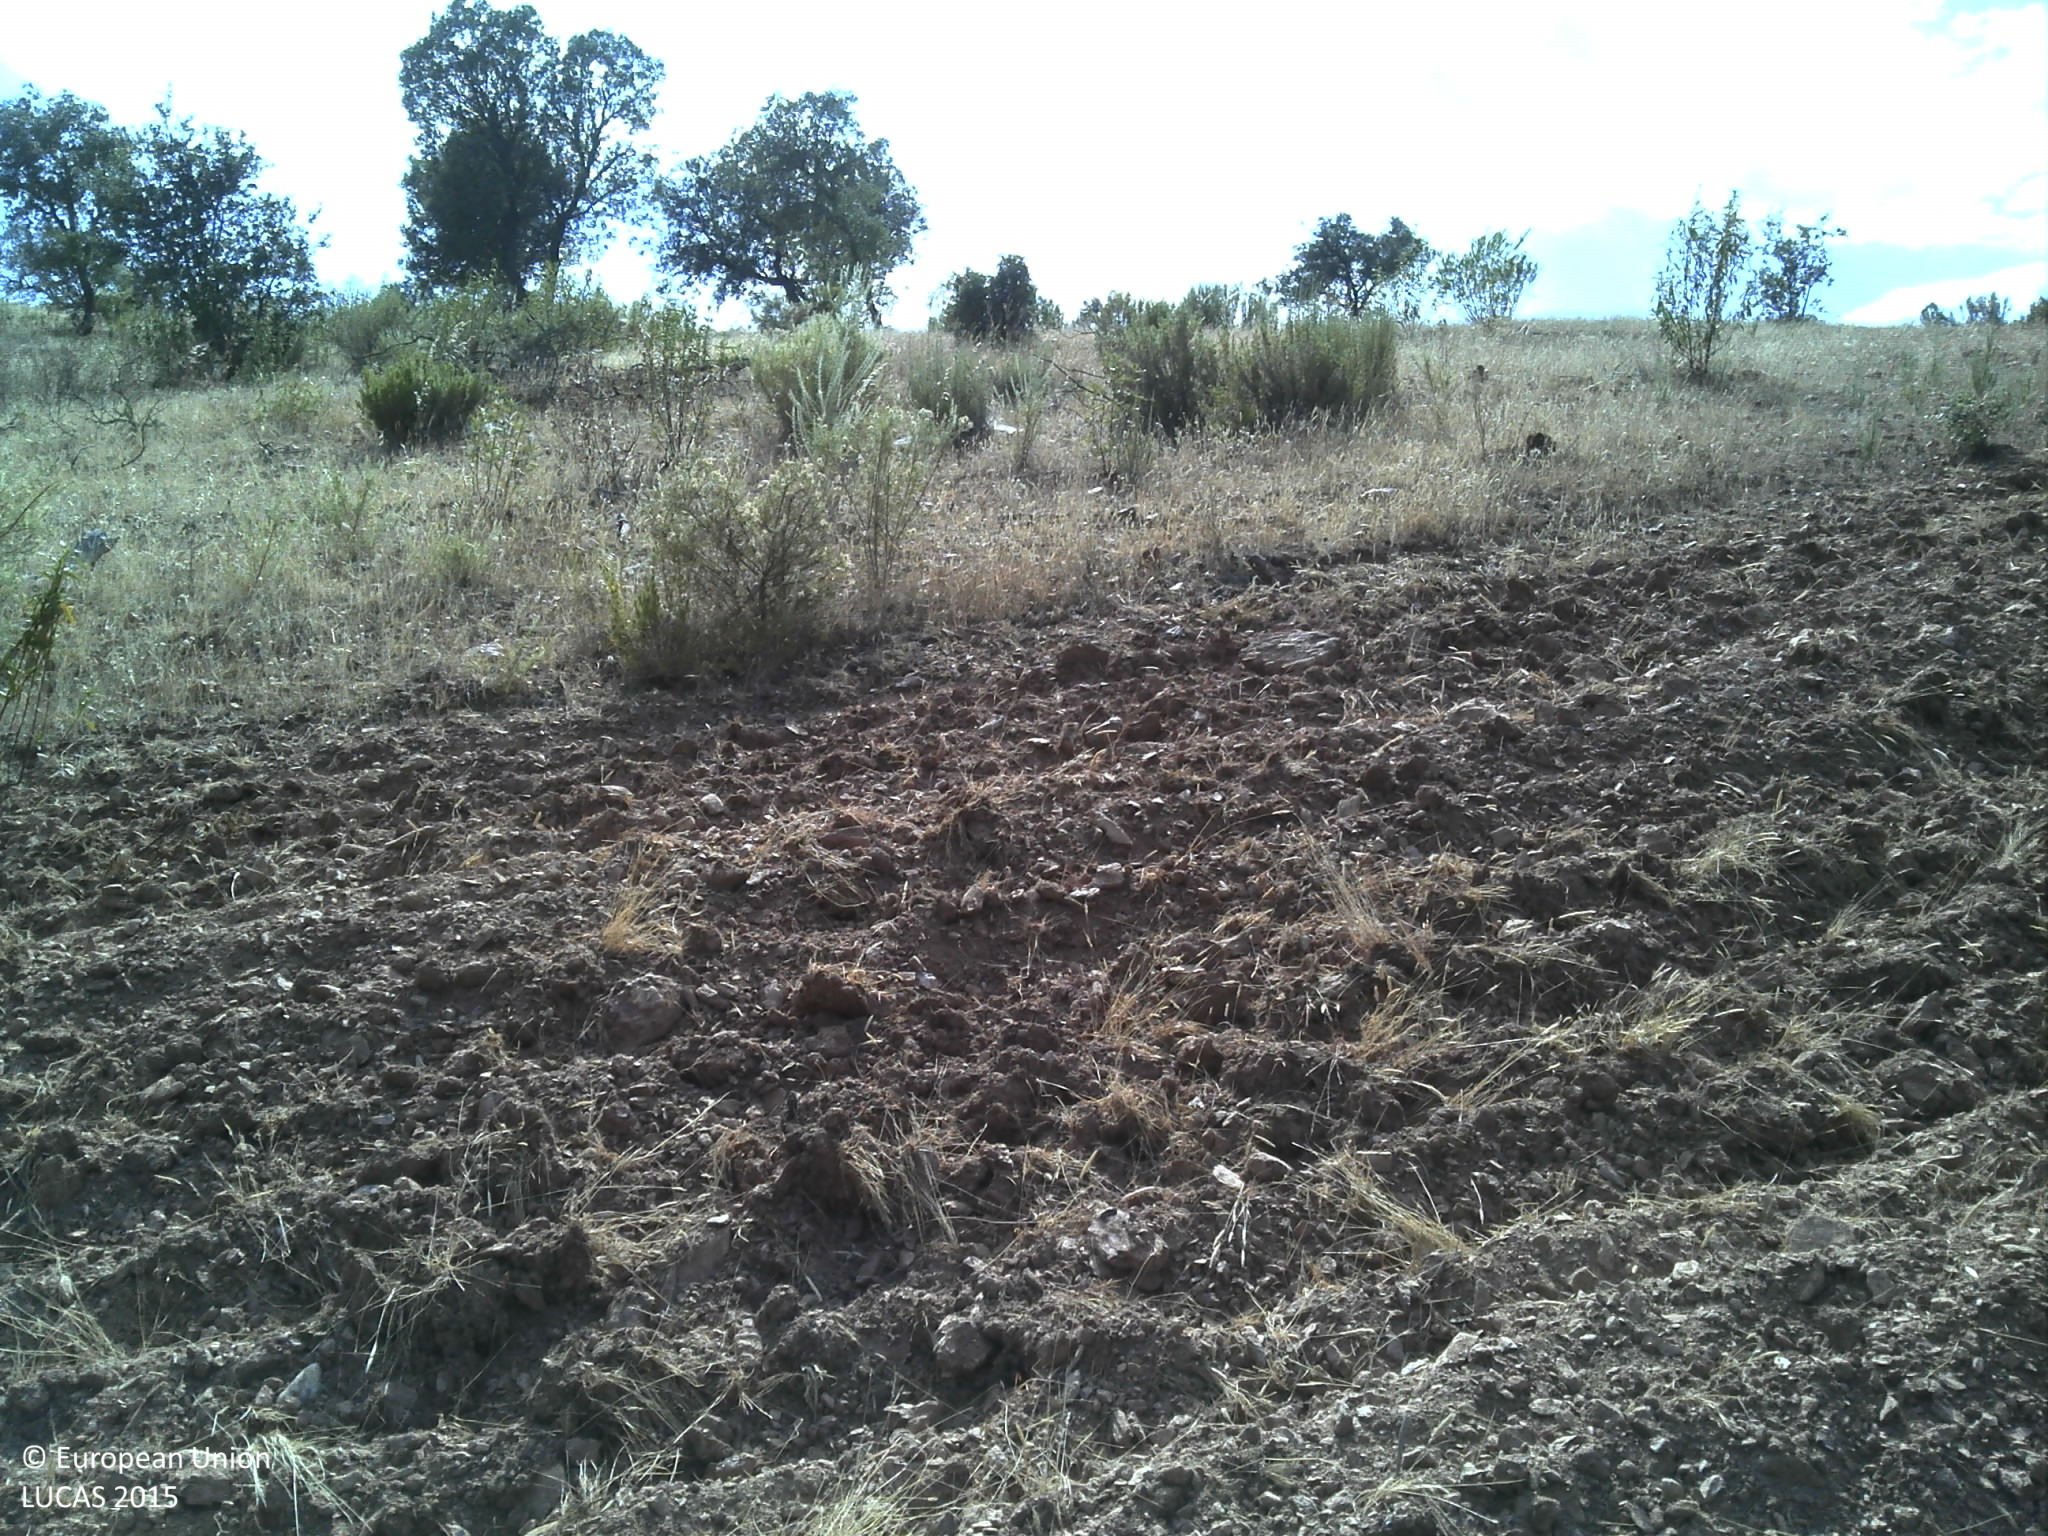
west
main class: Shrubland
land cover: Shrubland with sparse tree cover
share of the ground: > 75 %
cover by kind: shrubs 75 %, unconsolidated bare surface 15 %, broadleaved forest trees 5 %, herbaceous plants 5 %
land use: Forestry
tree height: > 5 m
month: June
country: PT
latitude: 37.8181
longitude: -7.5682
